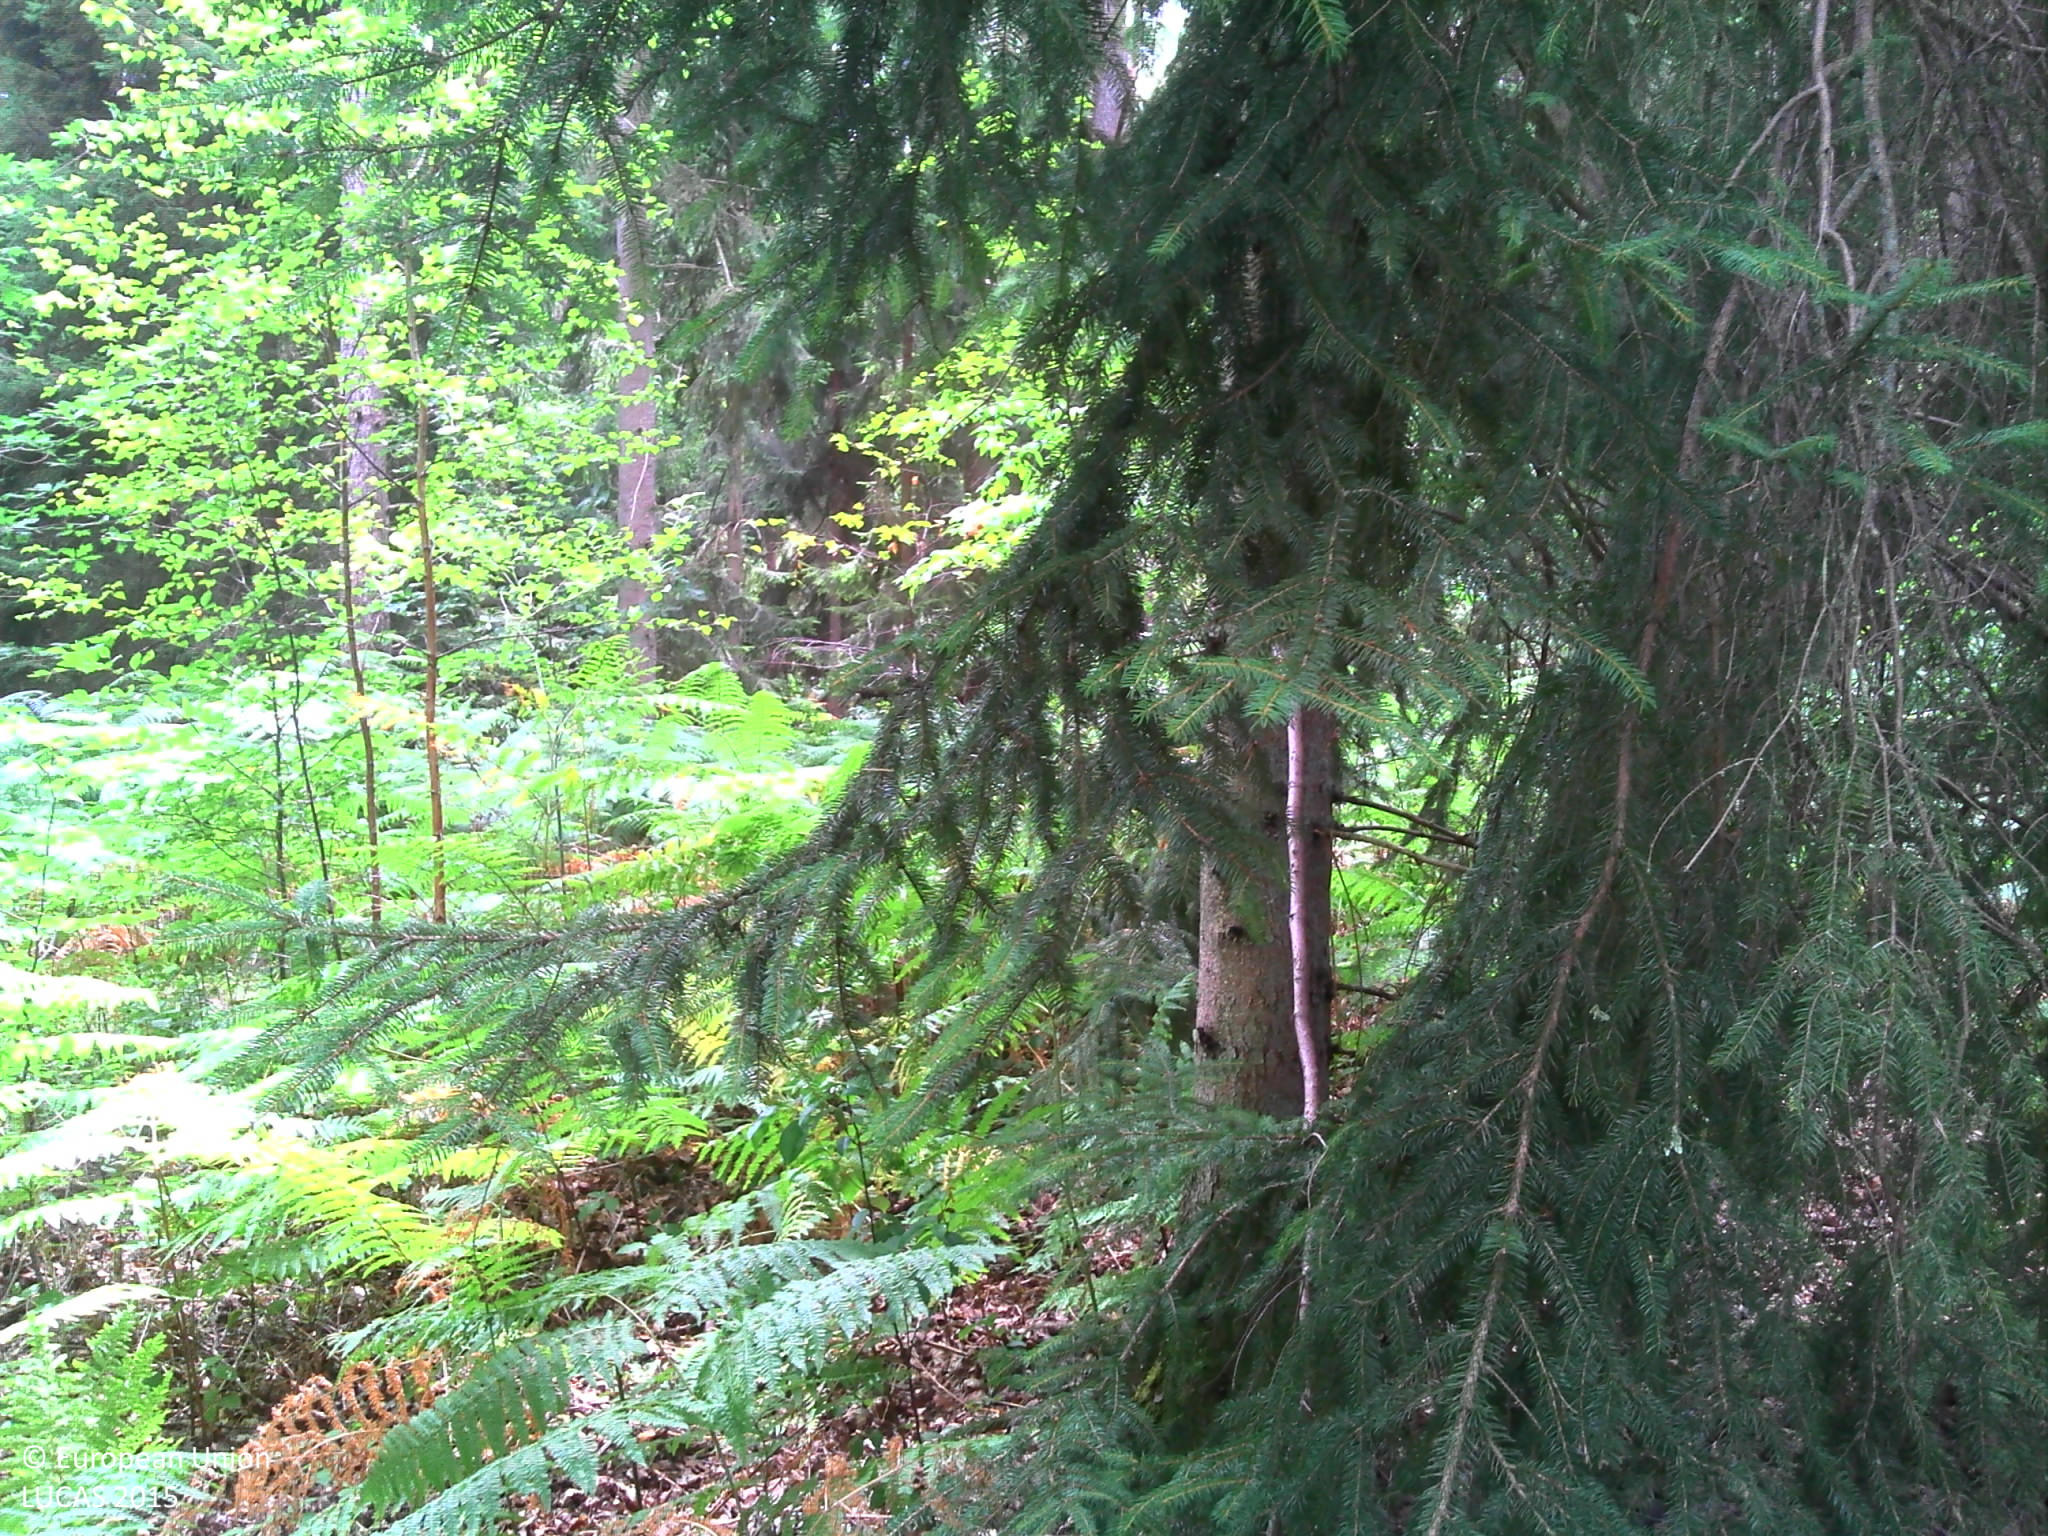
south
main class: Woodland
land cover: Pine dominated mixed woodland
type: hemiboreal forest and nemoral coniferous forest and mixed broadleaved-coniferous forest
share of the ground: > 75 %
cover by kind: coniferous forest trees 40 %, broadleaved forest trees 20 %, herbaceous plants 15 %, lichens and mosses 10 %, unconsolidated bare surface 10 %
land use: Forestry
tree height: > 5 m
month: July
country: FR
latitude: 48.4352
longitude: 2.7324
